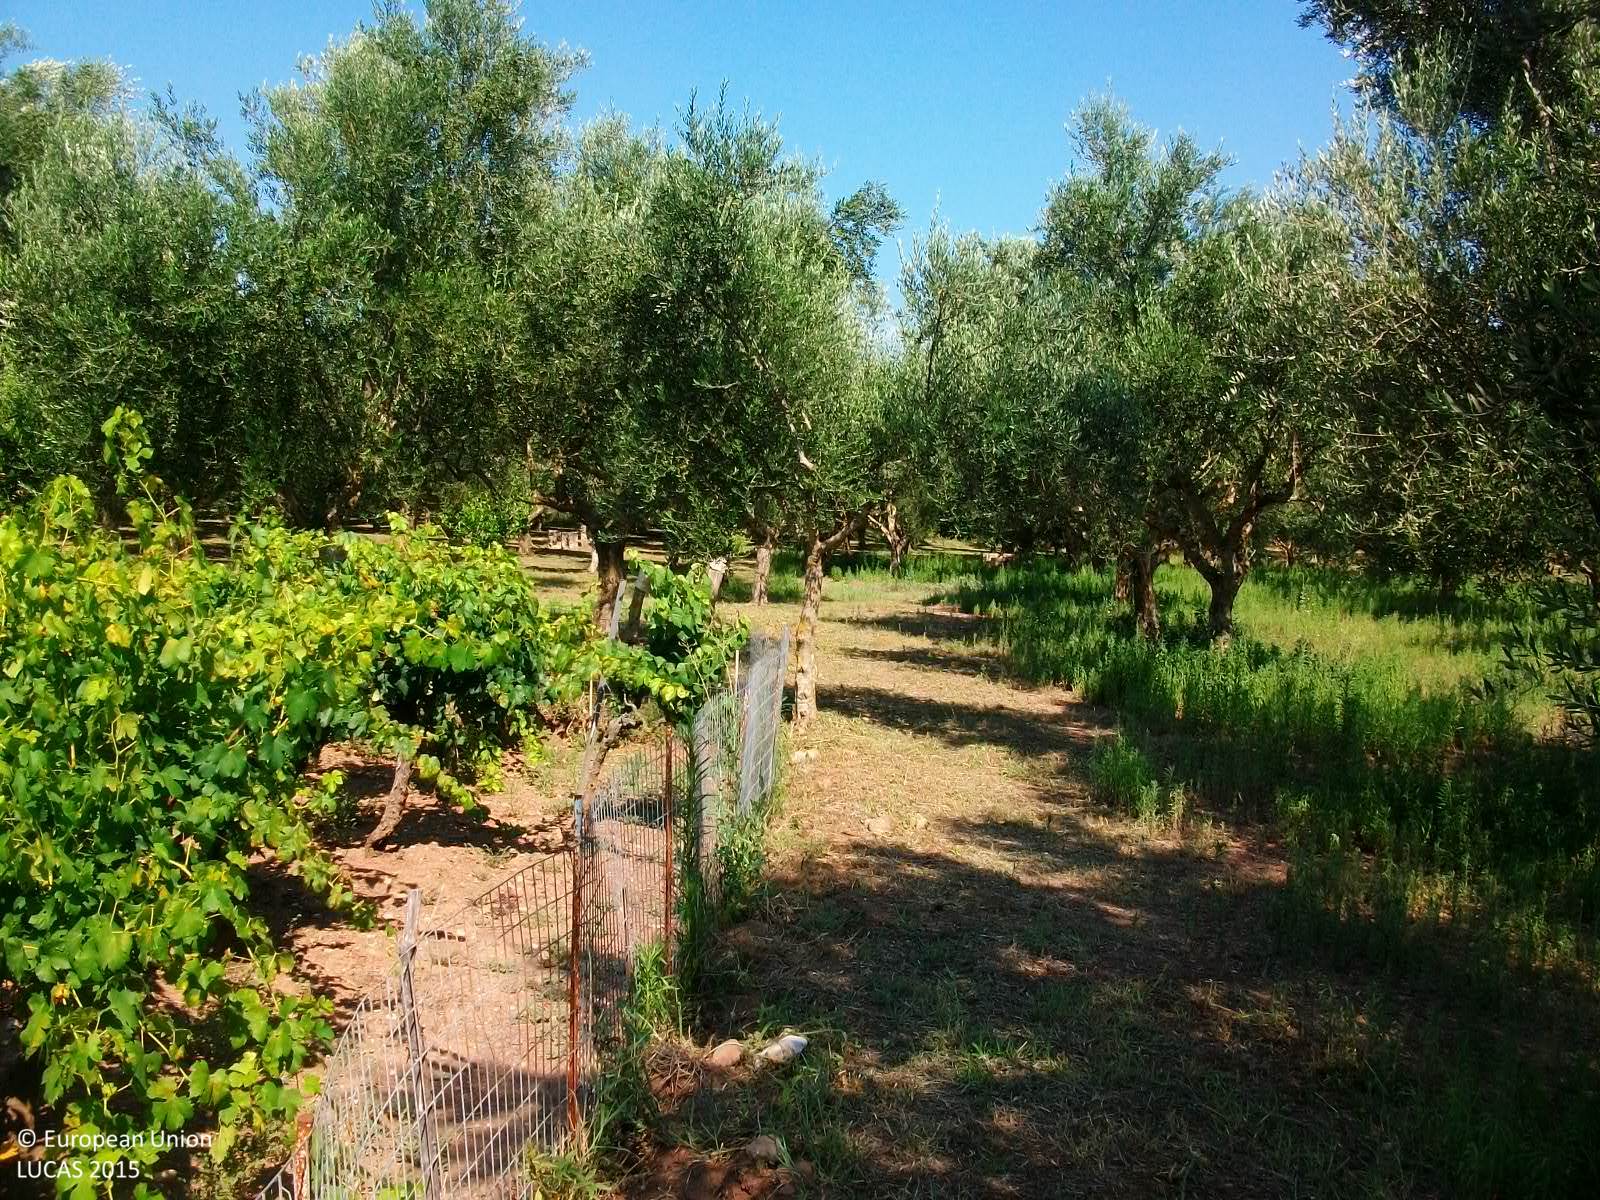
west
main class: Cropland
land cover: Olive groves
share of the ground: 25 - 50 %
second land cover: Spontaneously vegetated surfaces
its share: > 75 %
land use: Agriculture (excluding fallow land and kitchen gardens)
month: July
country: GR
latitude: 37.1357
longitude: 21.9654
